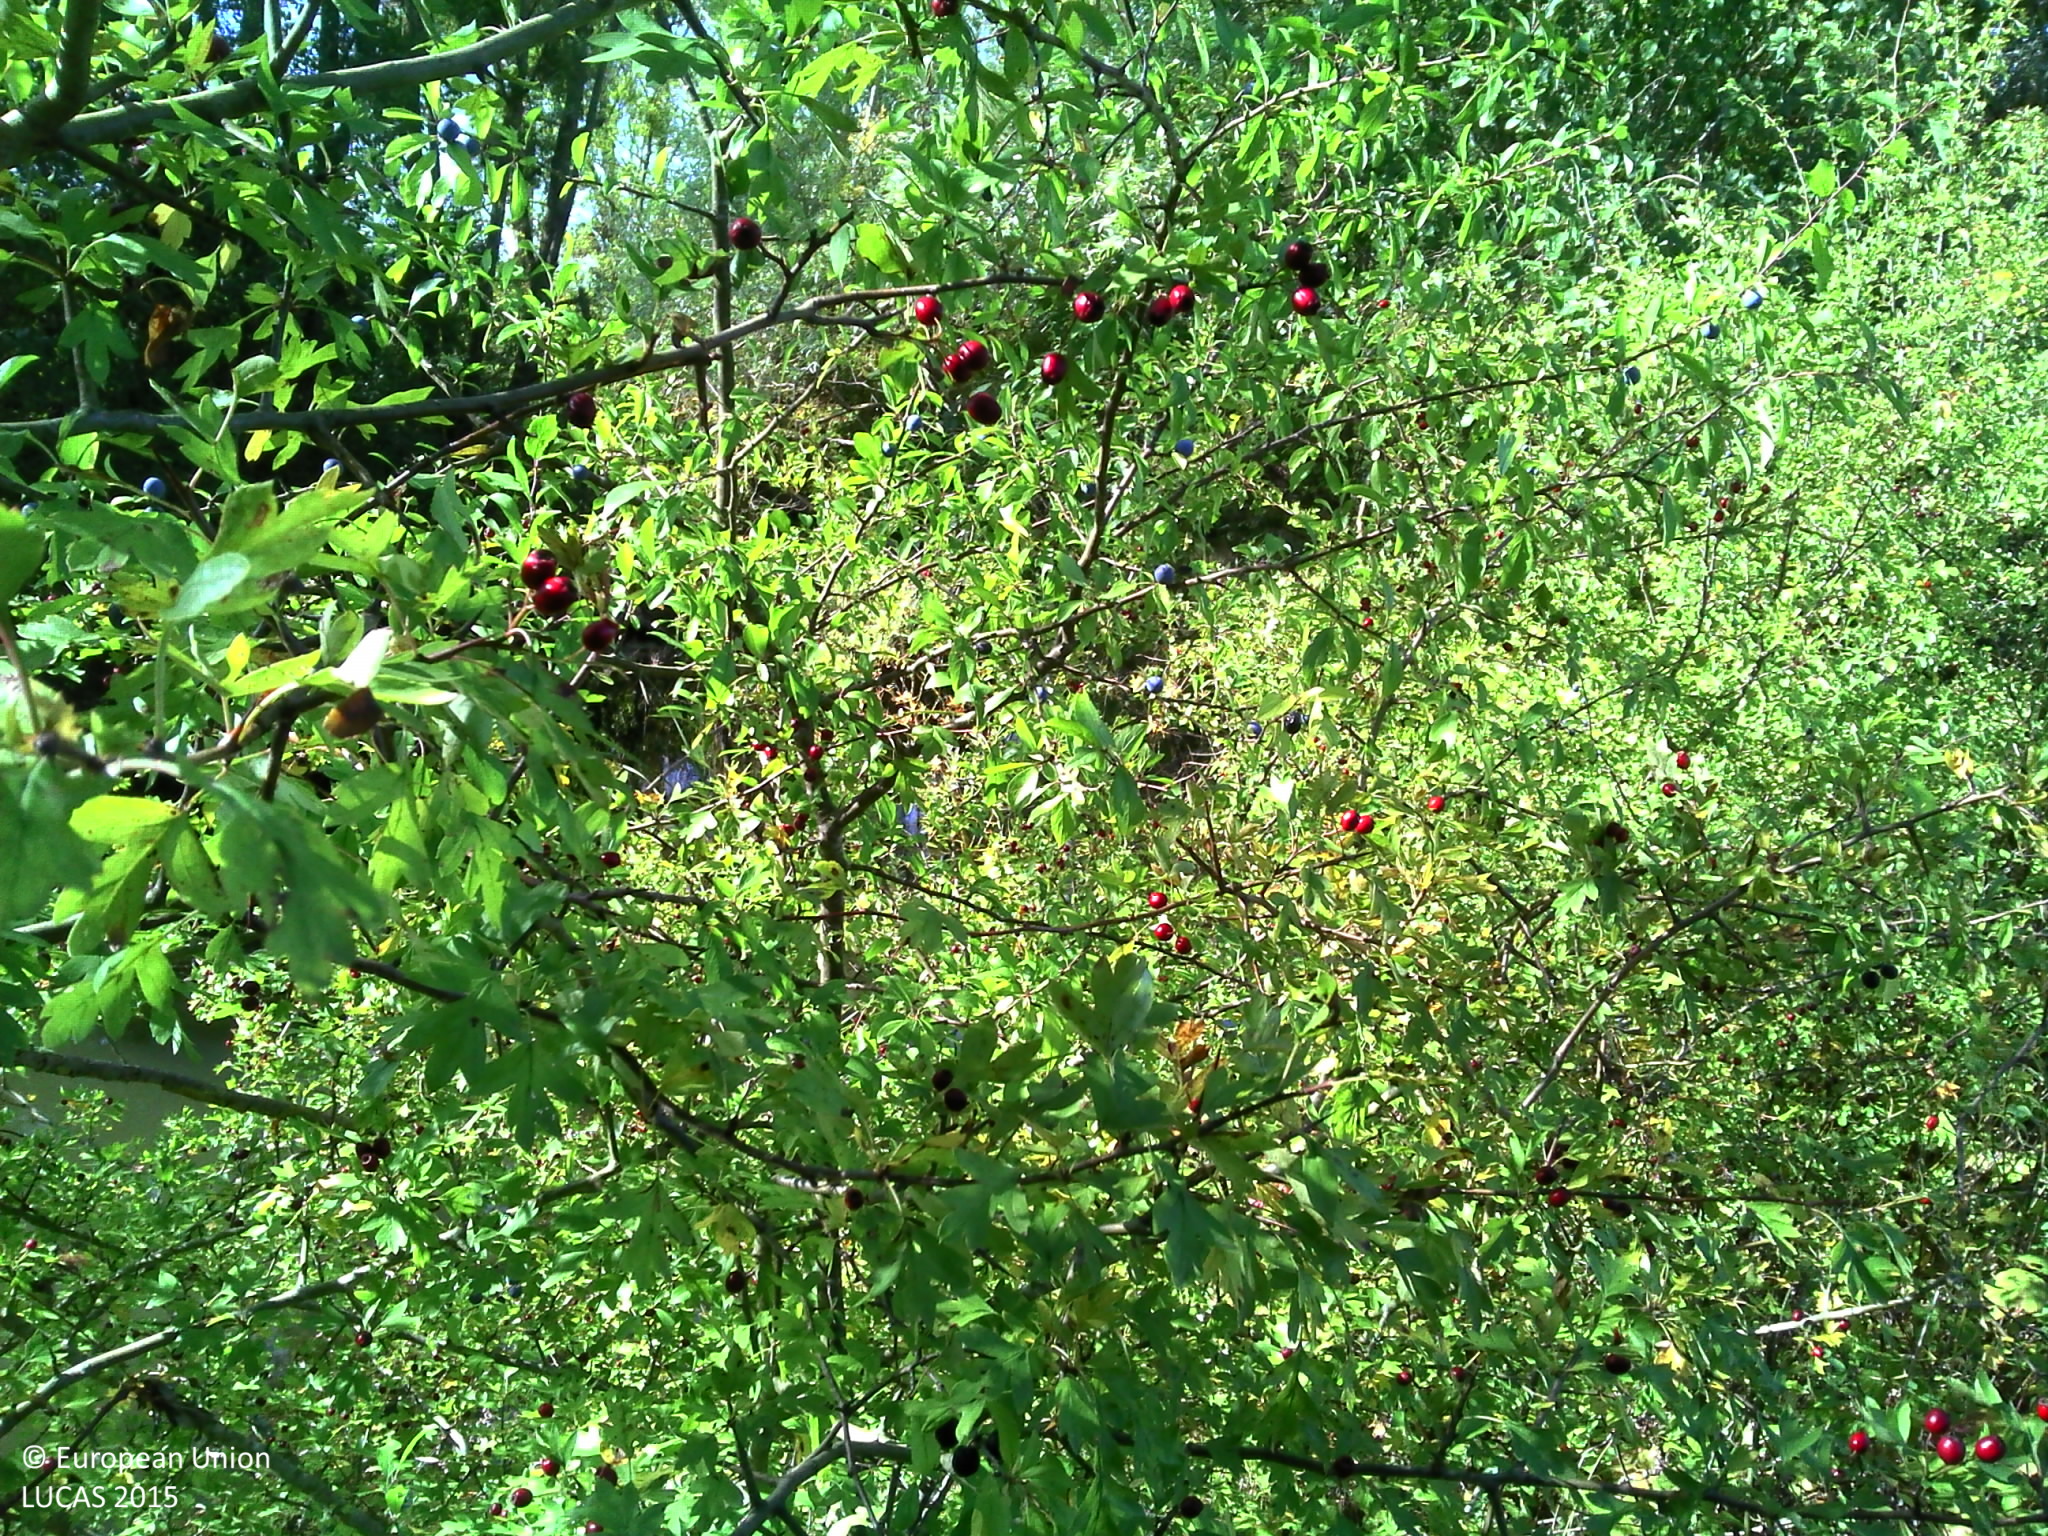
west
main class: Woodland
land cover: Broadleaved woodland
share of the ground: > 75 %
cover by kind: broadleaved forest trees 100 %
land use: Semi-natural and natural areas not in use
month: September
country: FR
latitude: 48.1626
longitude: 4.2292
